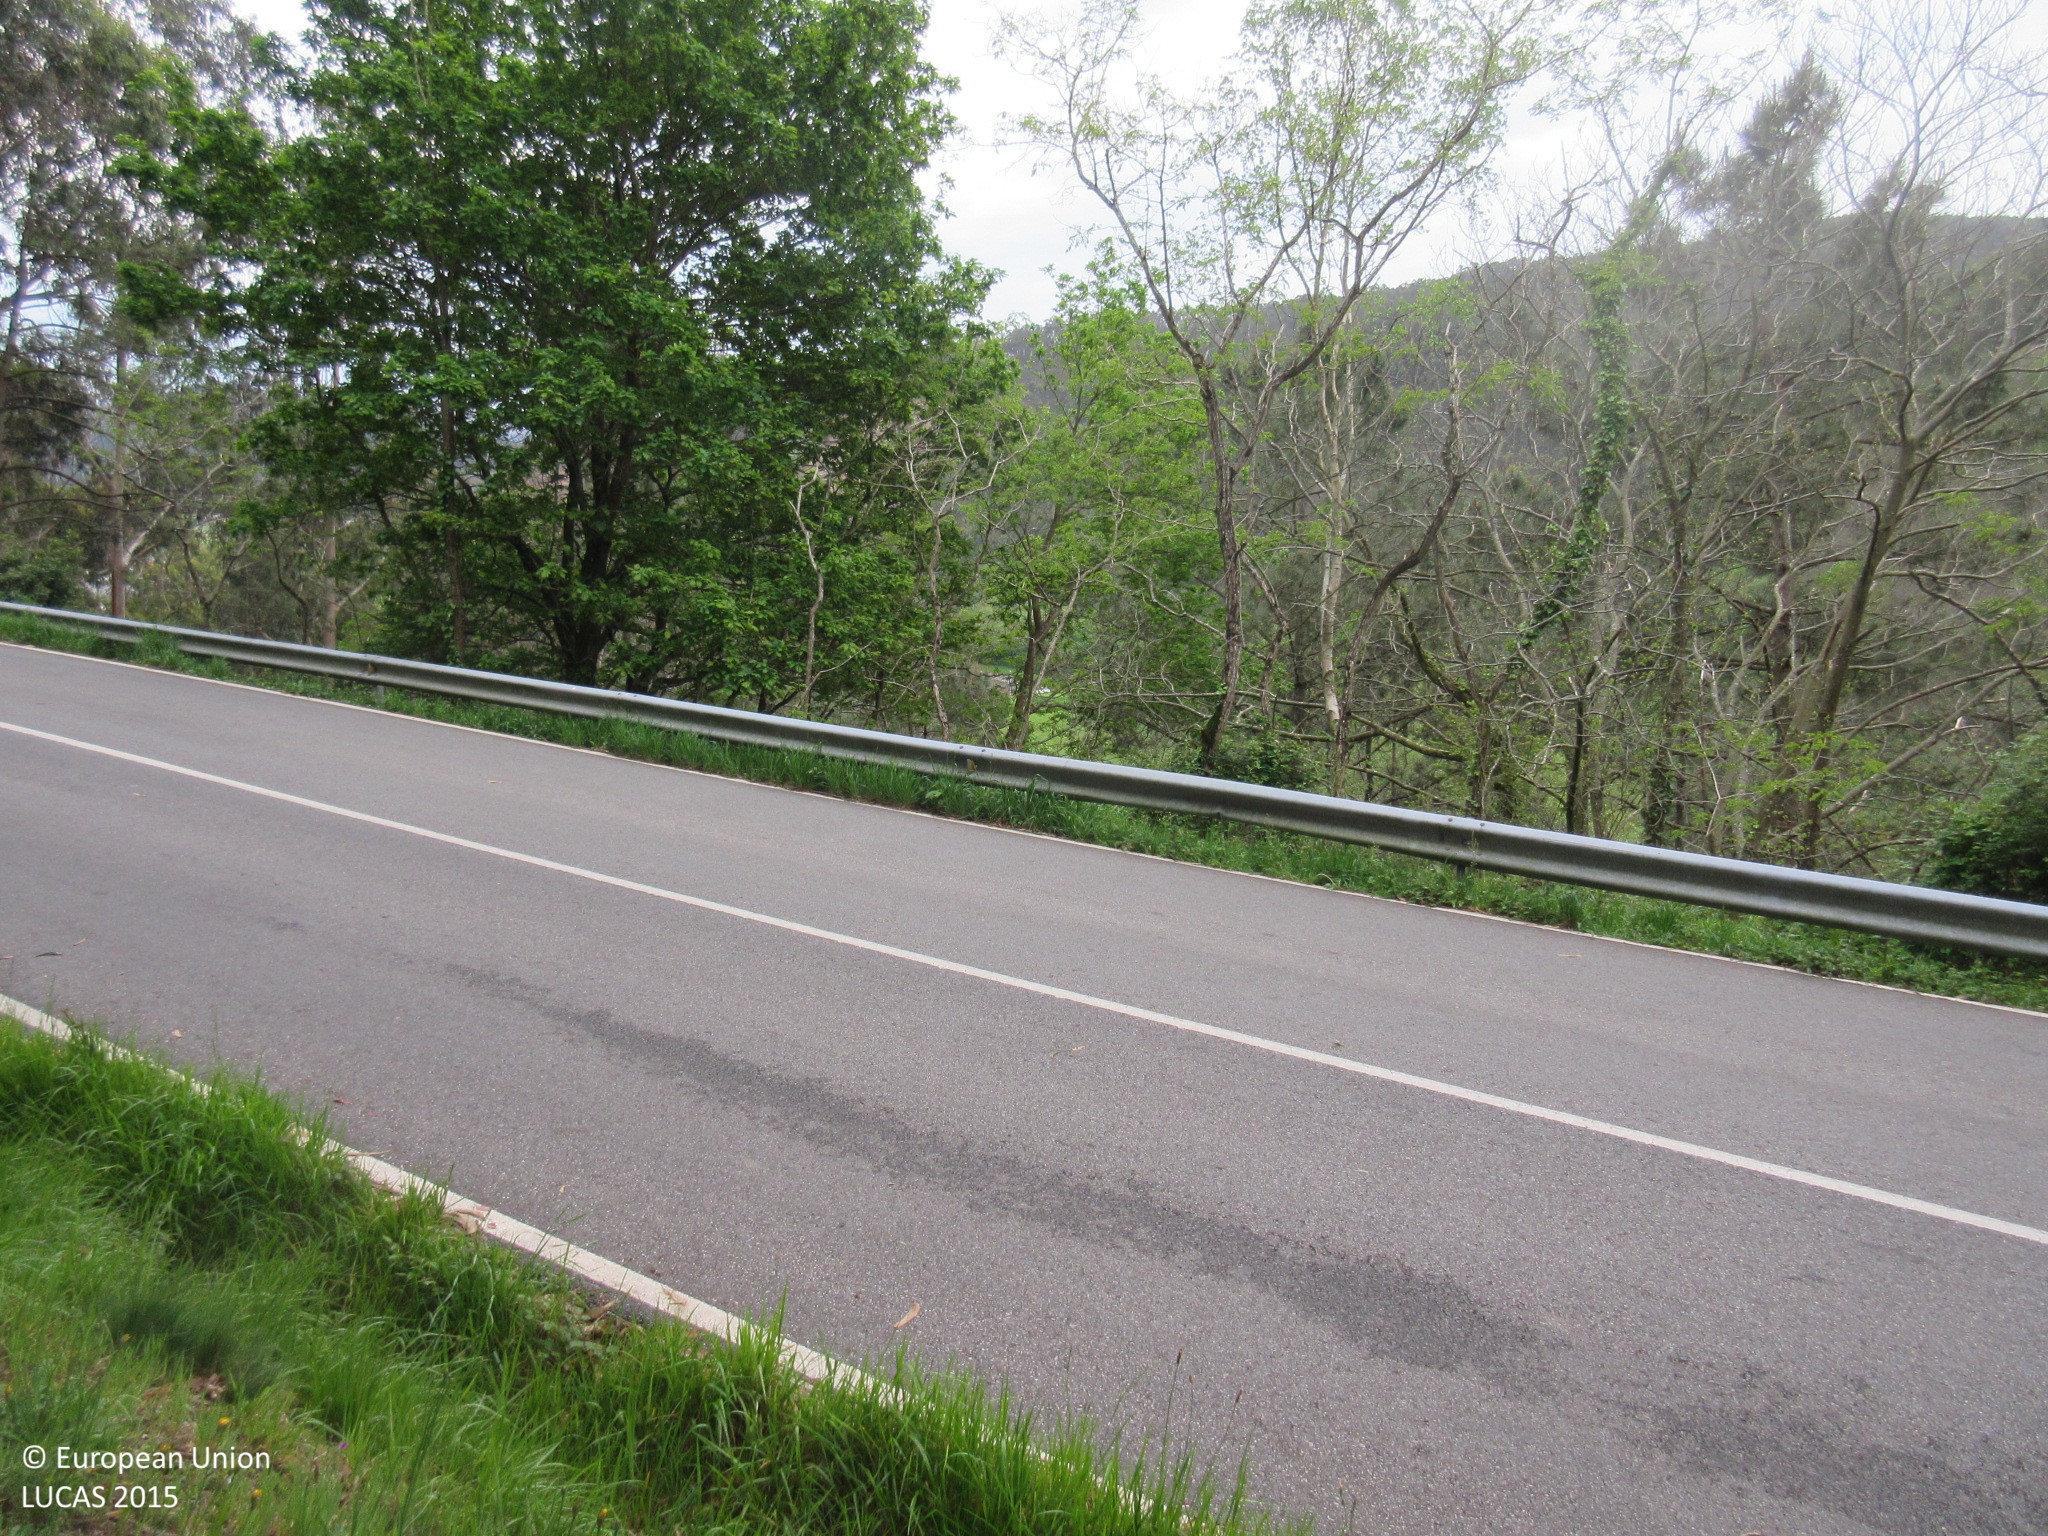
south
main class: Shrubland
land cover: Shrubland with sparse tree cover
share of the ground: > 75 %
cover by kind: shrubs 95 %, coniferous forest trees 5 %
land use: Forestry
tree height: > 5 m
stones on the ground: 10 - 25 %
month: April
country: ES
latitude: 43.5410
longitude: -6.4524
